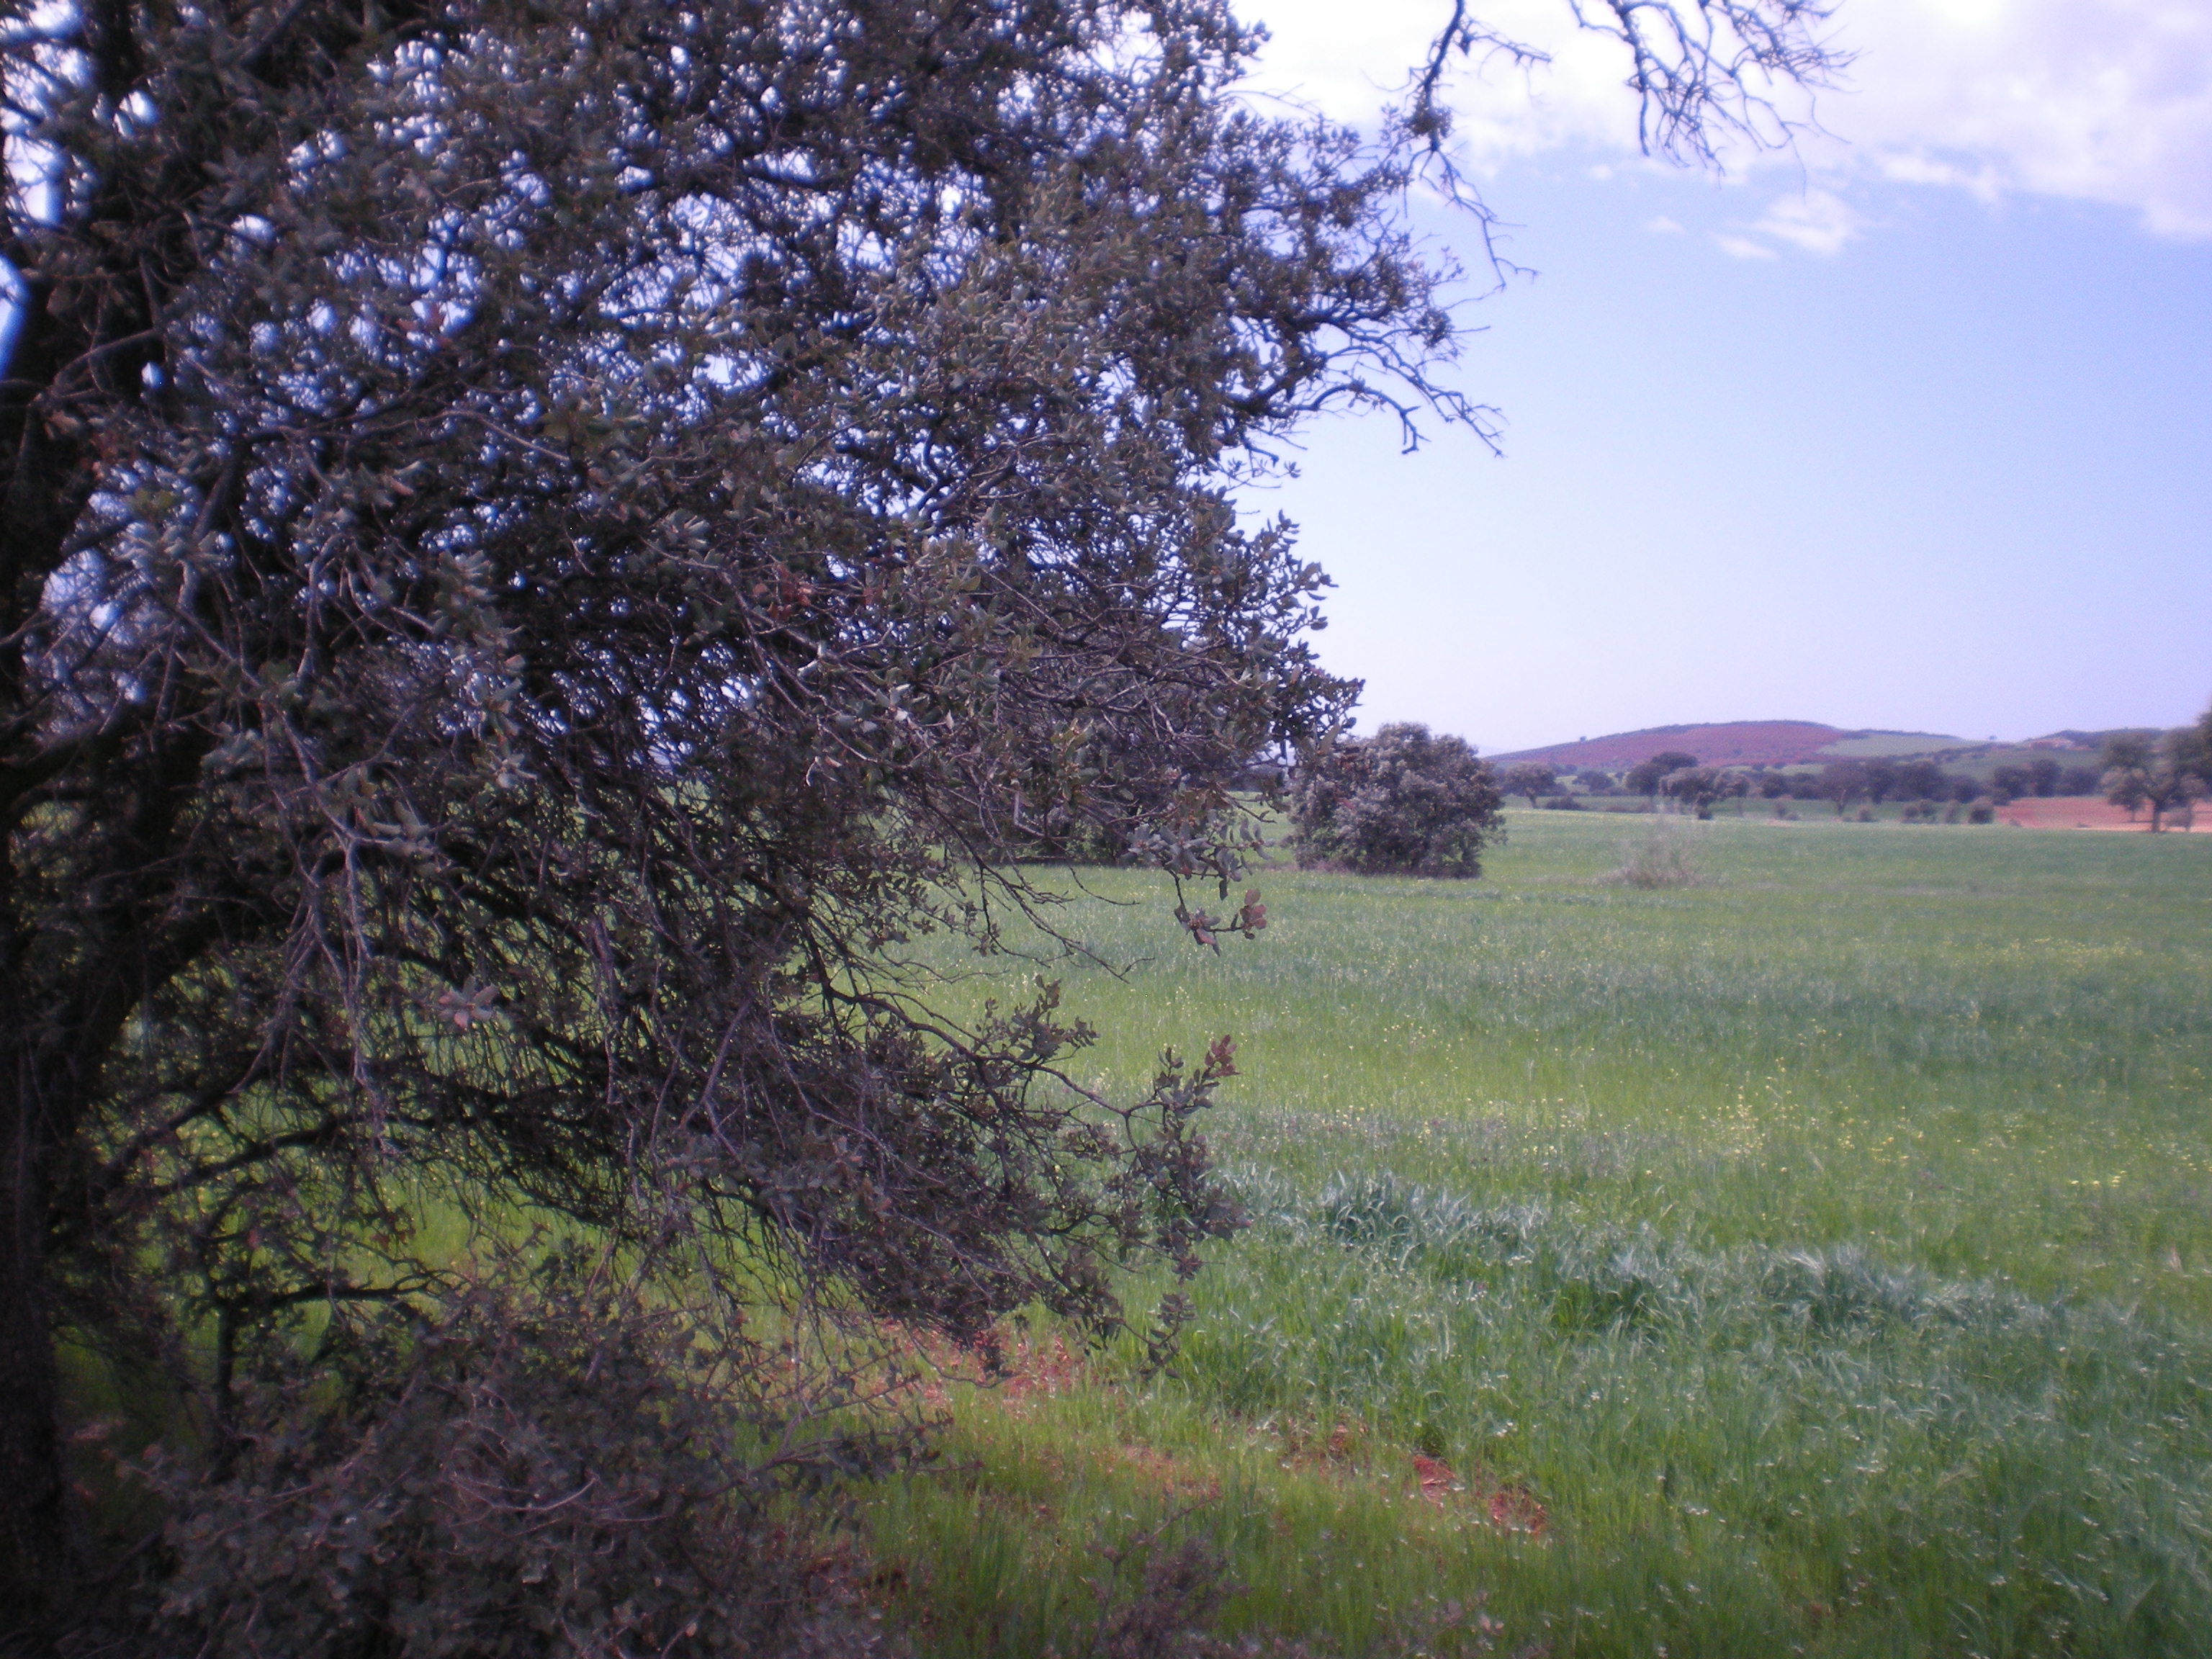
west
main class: Cropland
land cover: Oats
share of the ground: > 75 %
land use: Agriculture (excluding fallow land and kitchen gardens)
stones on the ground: 10 - 25 %
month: April
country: ES
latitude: 38.5964
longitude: -3.5009
